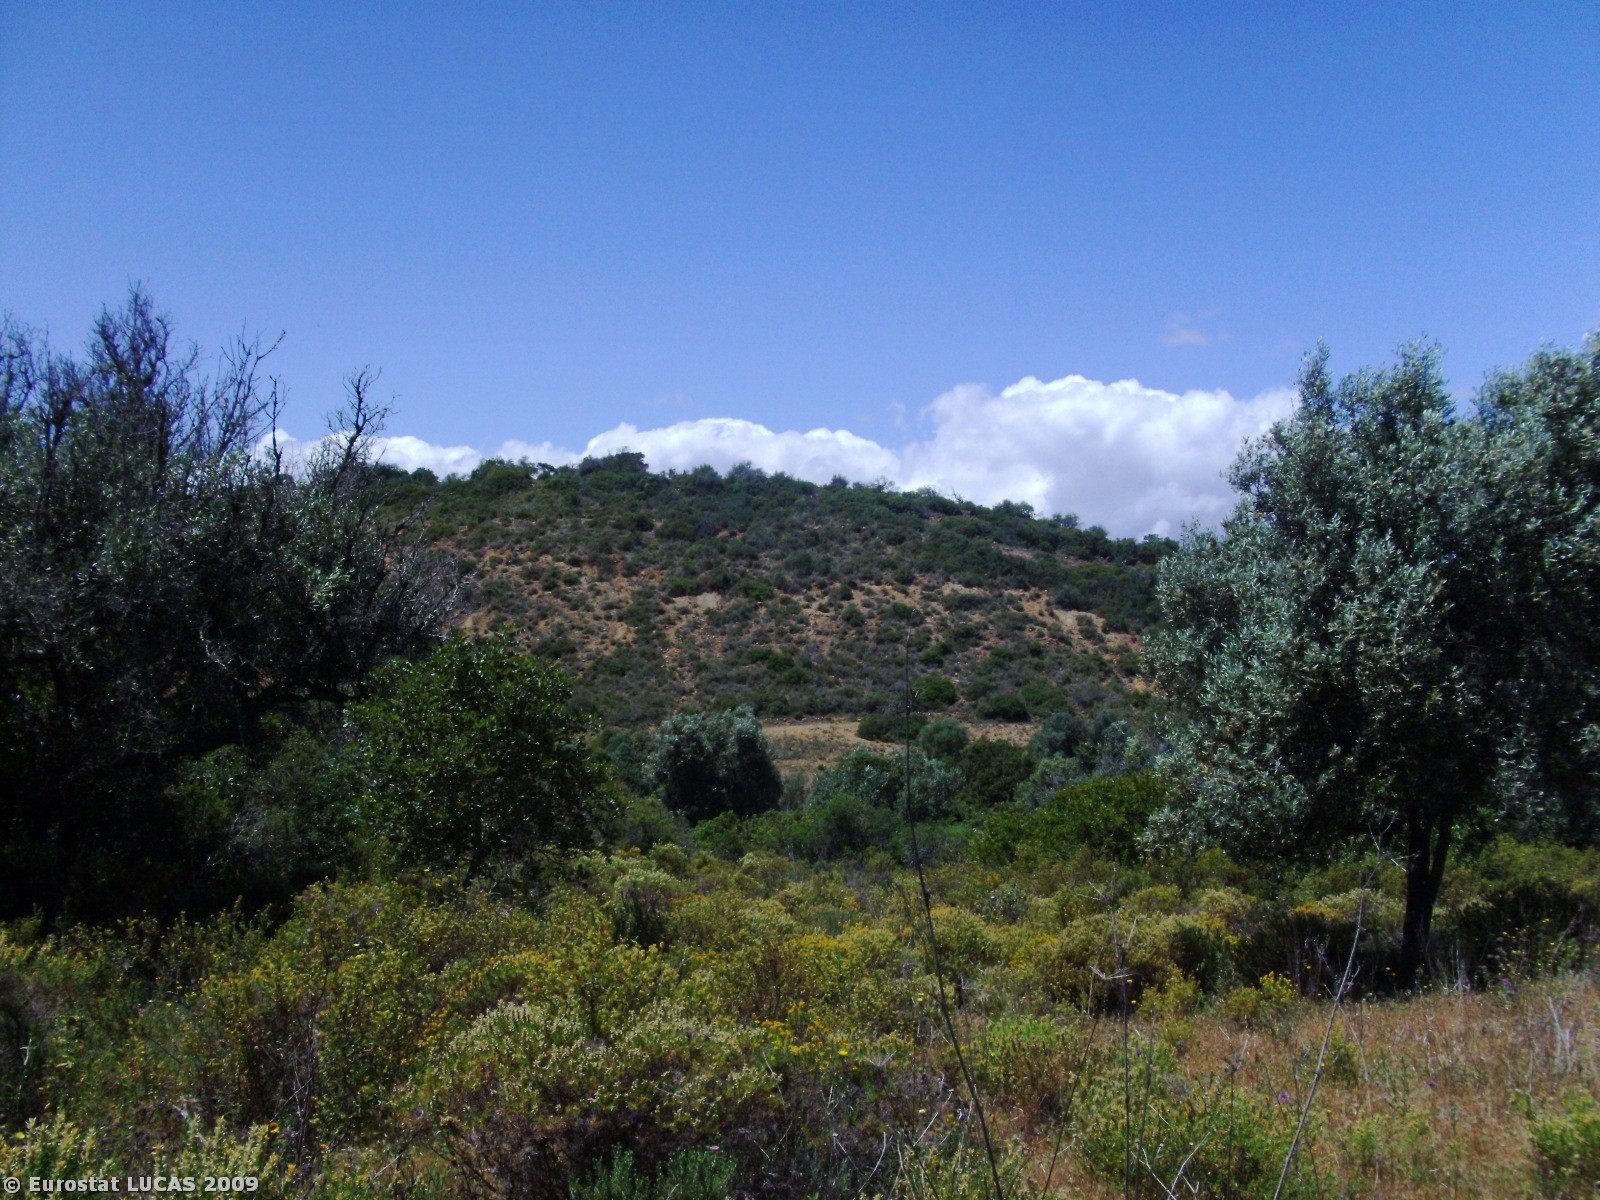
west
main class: Grassland
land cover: Grassland with sparse tree/shrub cover
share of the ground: > 75 %
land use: Fallow land
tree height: > 5 m
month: May
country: PT
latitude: 37.1432
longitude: -8.3839
